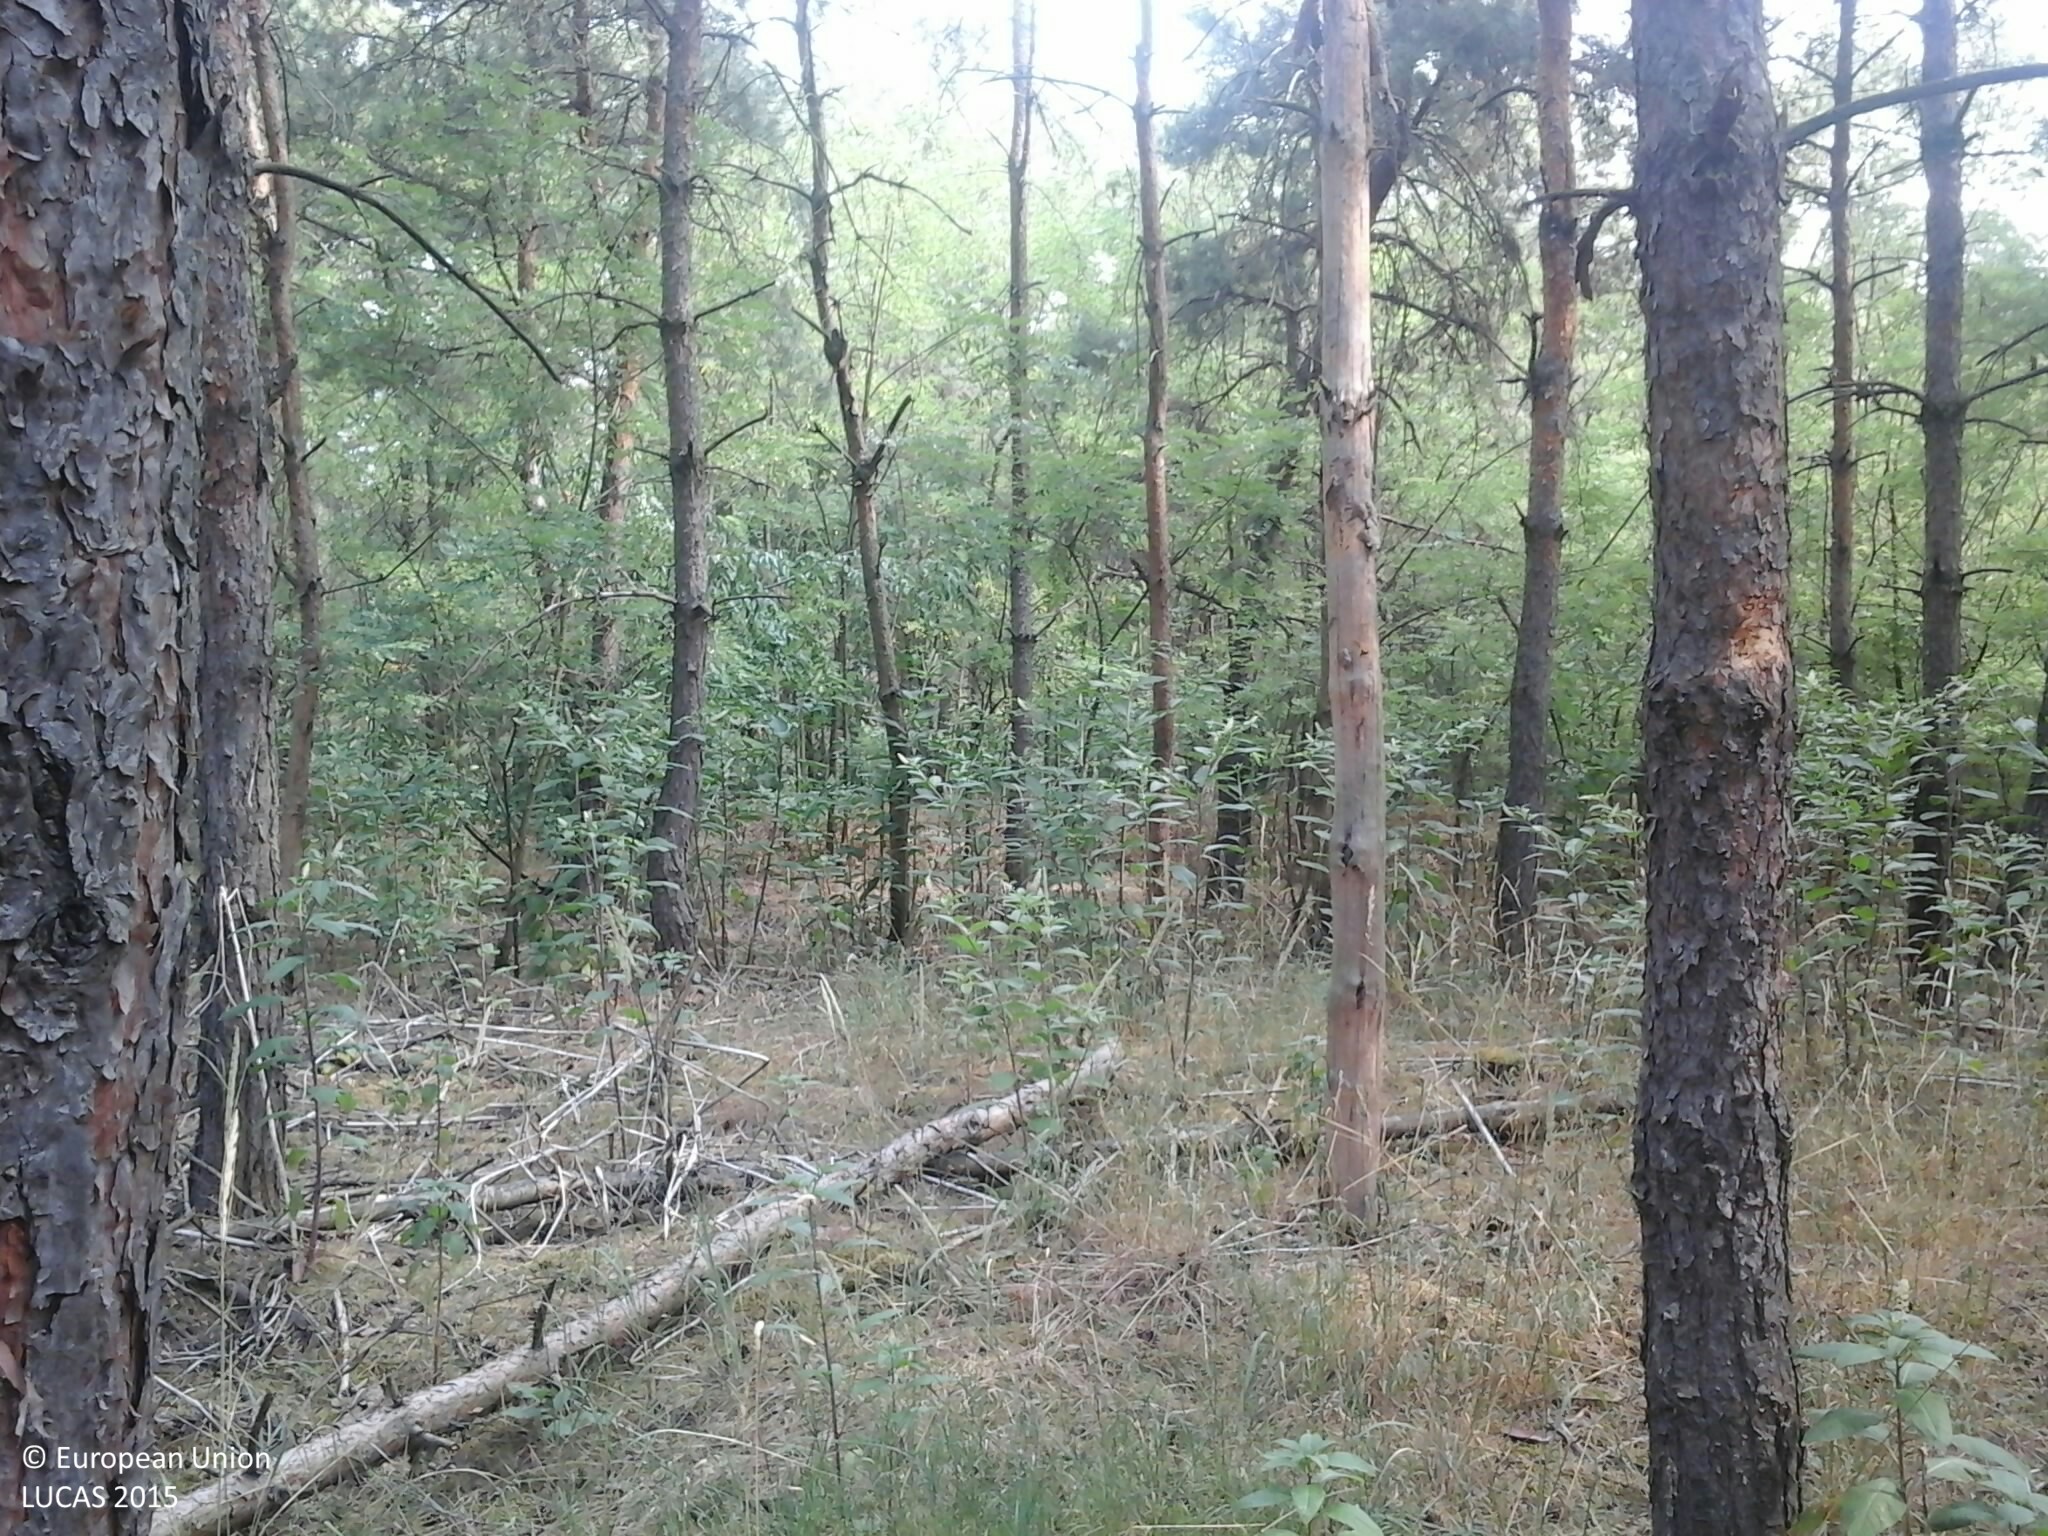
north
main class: Woodland
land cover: Pine dominated mixed woodland
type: hemiboreal forest and nemoral coniferous forest and mixed broadleaved-coniferous forest
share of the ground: > 75 %
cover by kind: coniferous forest trees 70 %, broadleaved forest trees 25 %, lichens and mosses 5 %
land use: Forestry
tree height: > 5 m
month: July
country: HU
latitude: 47.7221
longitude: 22.2255
